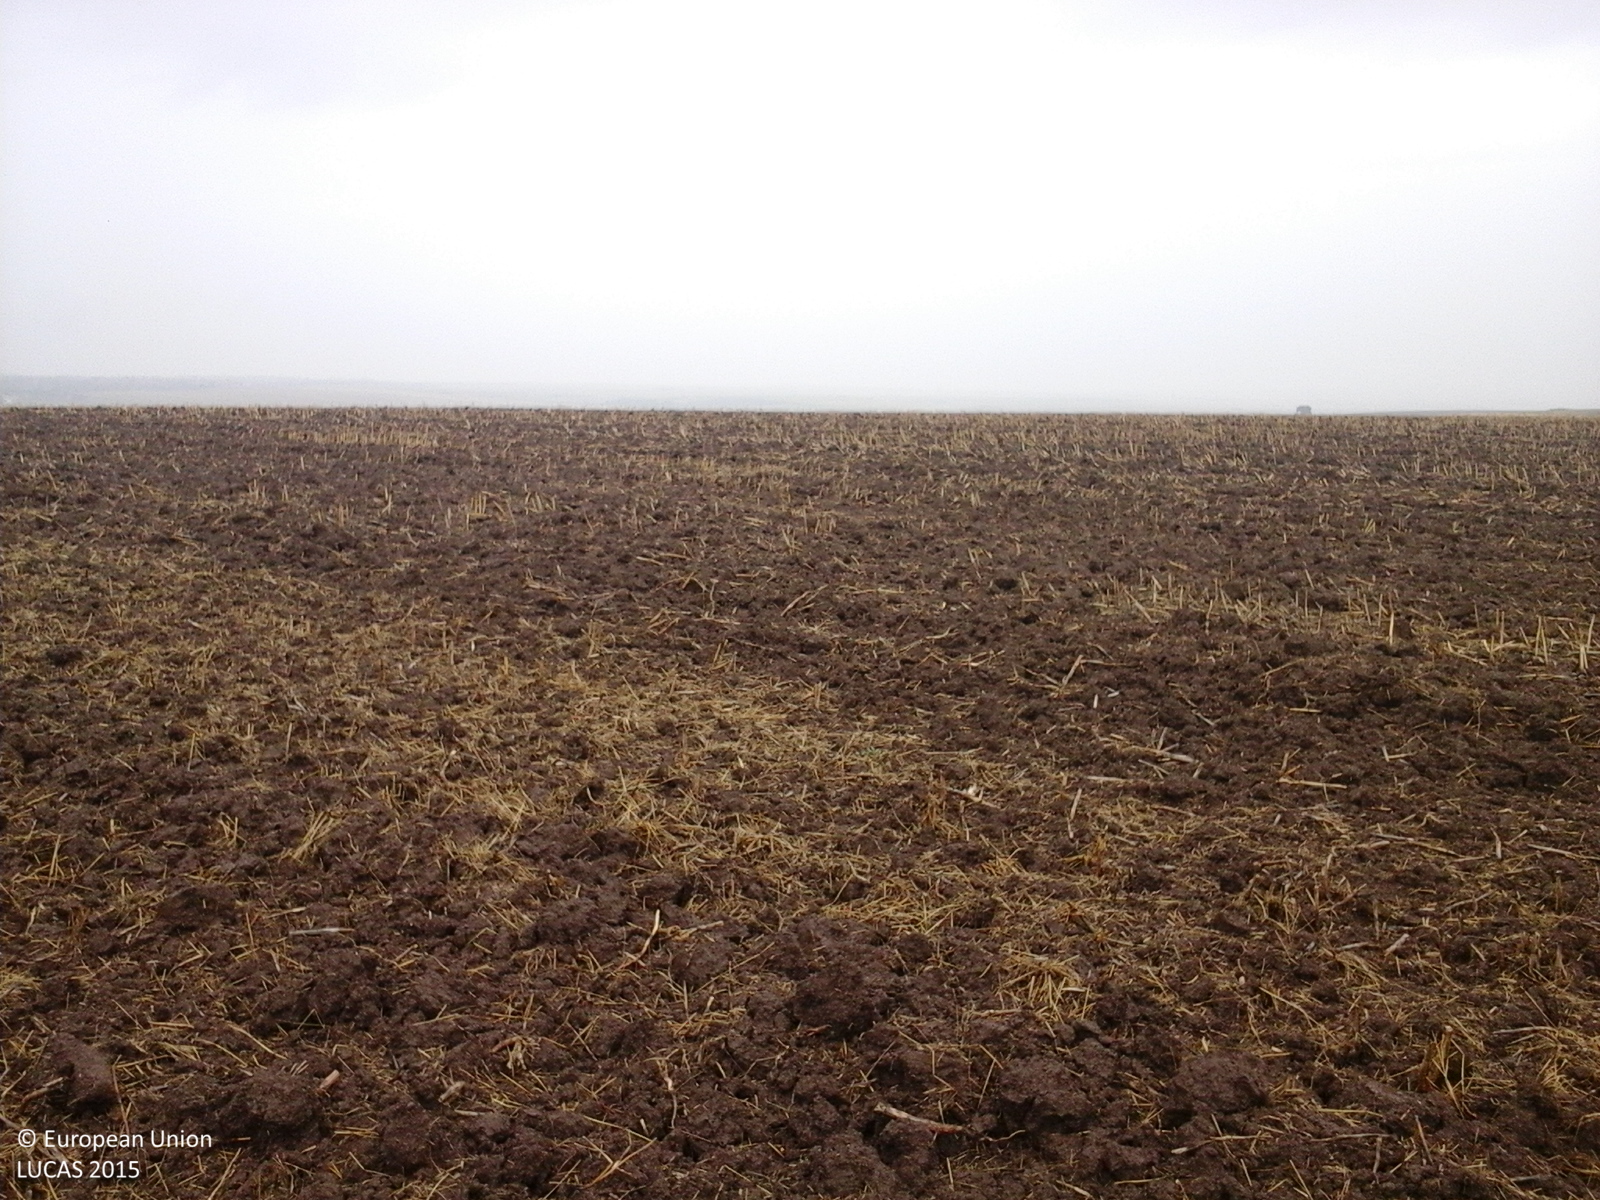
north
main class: Grassland
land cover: Spontaneously vegetated surfaces
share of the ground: > 75 %
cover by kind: herbaceous plants 100 %
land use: Fallow land
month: August
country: RO
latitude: 45.9372
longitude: 21.4226
